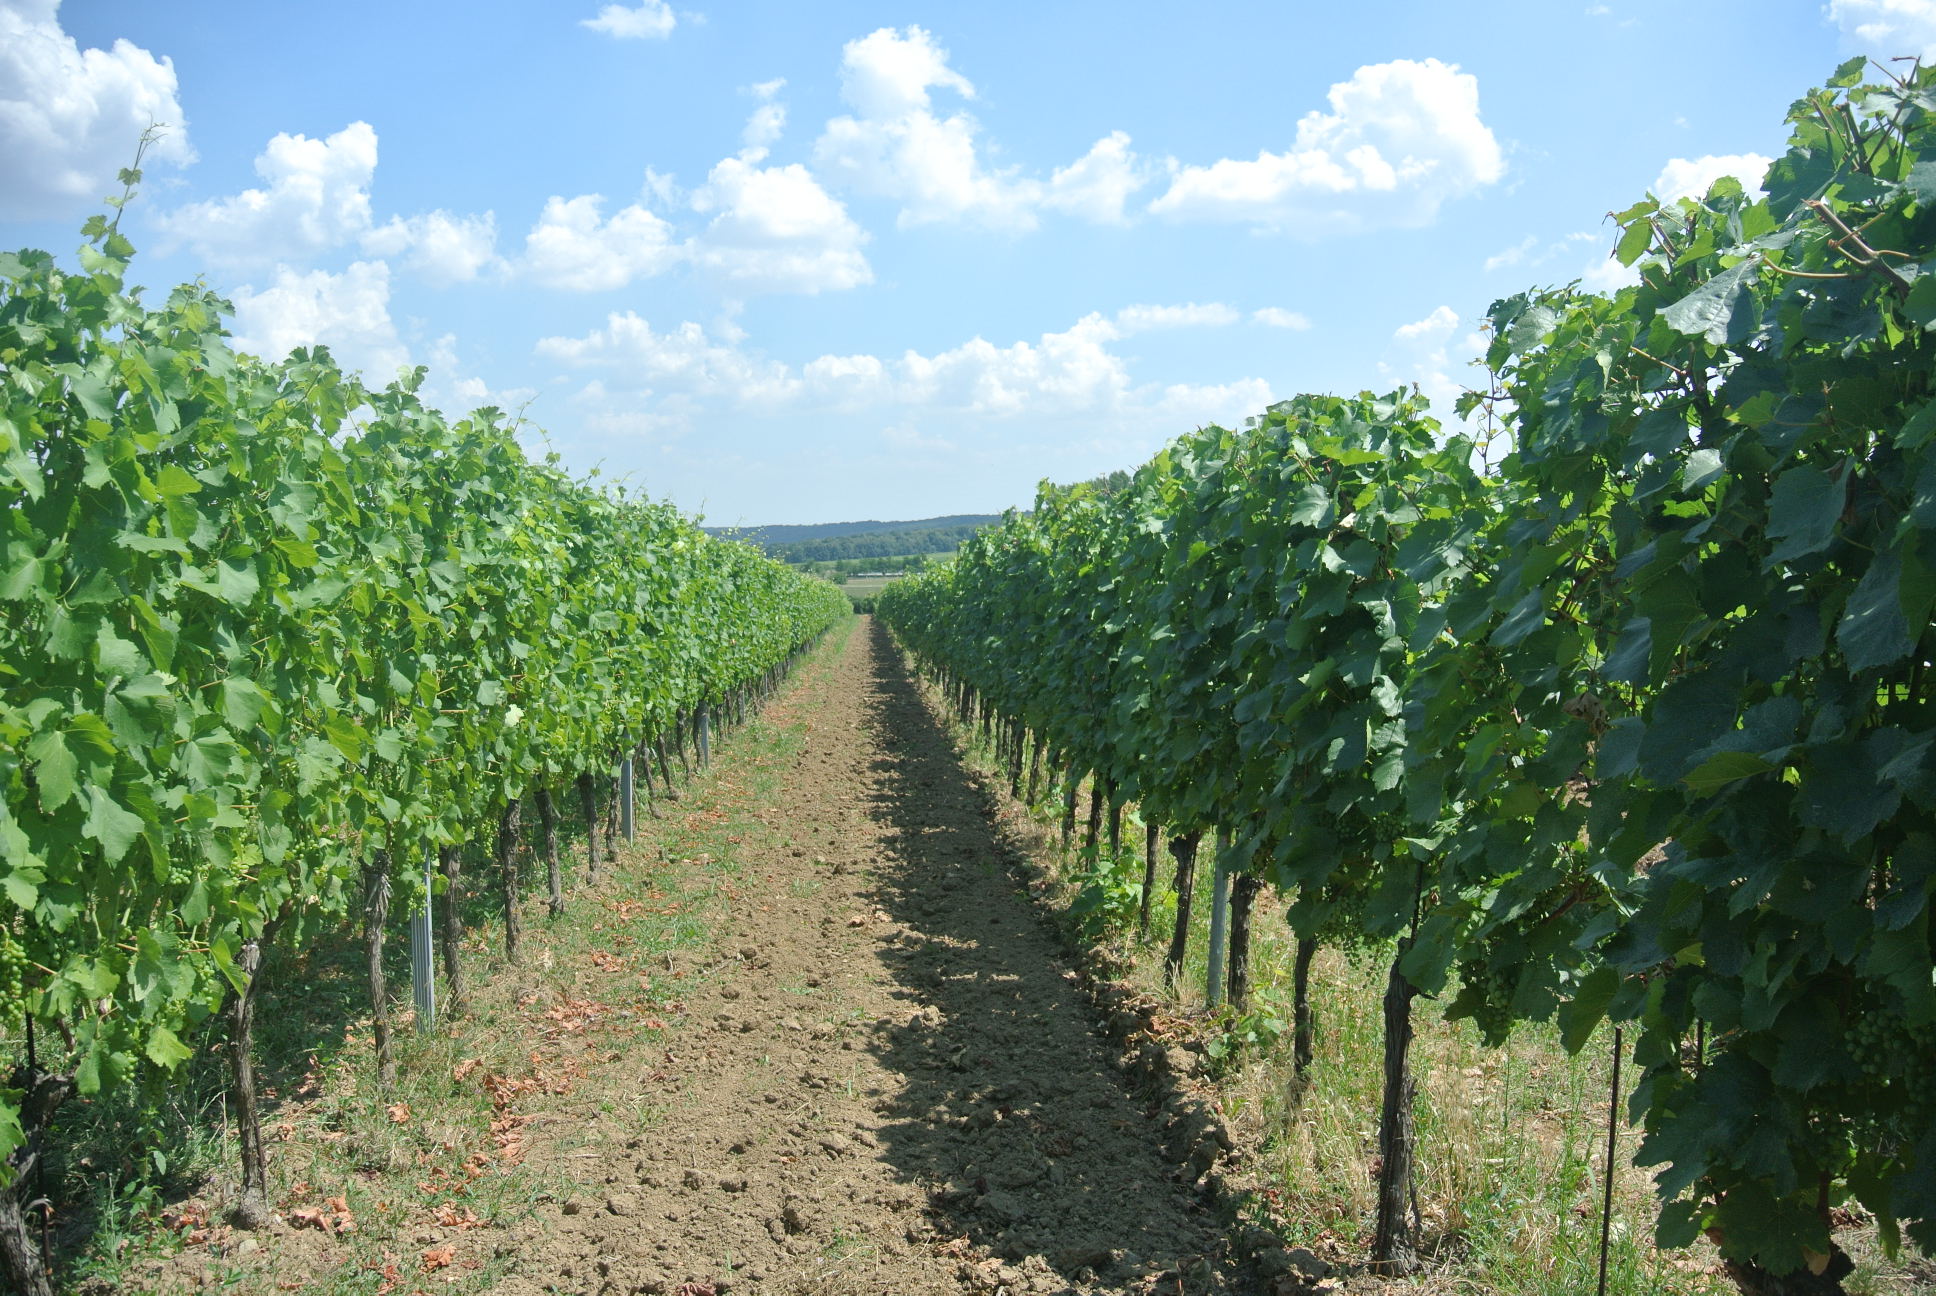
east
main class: Cropland
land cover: Vineyards
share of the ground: 25 - 50 %
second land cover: Other bare soil
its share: > 75 %
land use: Agriculture (excluding fallow land and kitchen gardens)
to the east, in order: Vineyards; Other bare soil; Vineyards; Grassland without tree/shrub cover
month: July
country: AT
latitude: 47.5768
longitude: 16.5584
